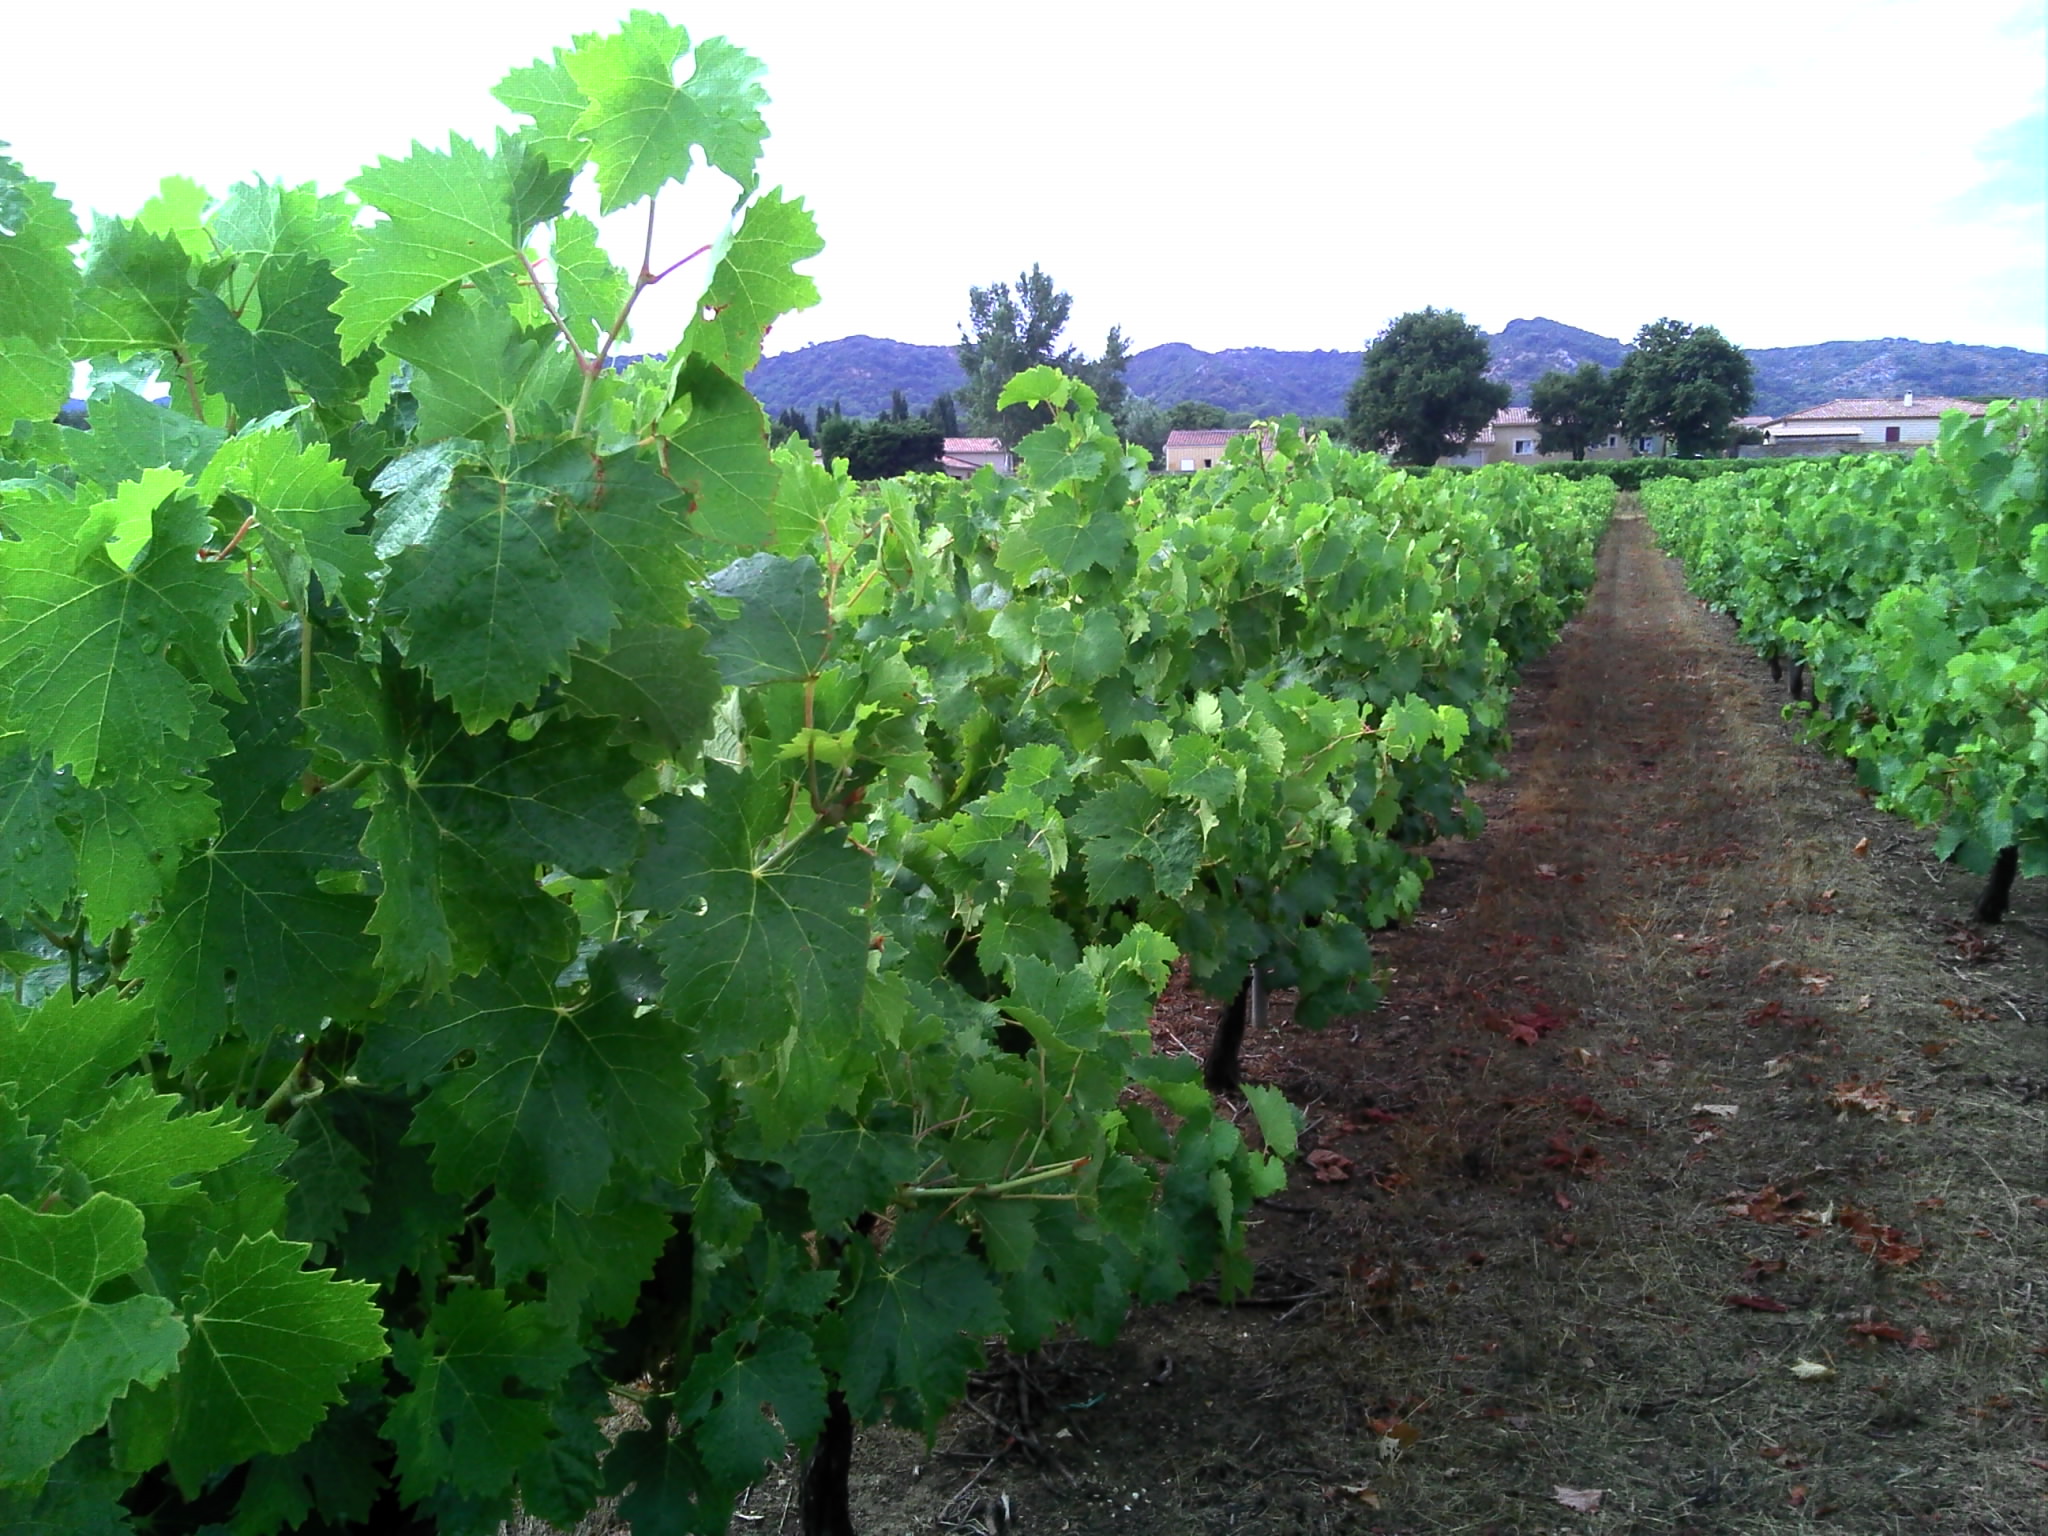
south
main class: Cropland
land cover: Vineyards
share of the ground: 25 - 50 %
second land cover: Spontaneously vegetated surfaces
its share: 50 - 75 %
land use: Agriculture (excluding fallow land and kitchen gardens)
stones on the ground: < 10 %
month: August
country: FR
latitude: 44.0681
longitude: 4.6520
